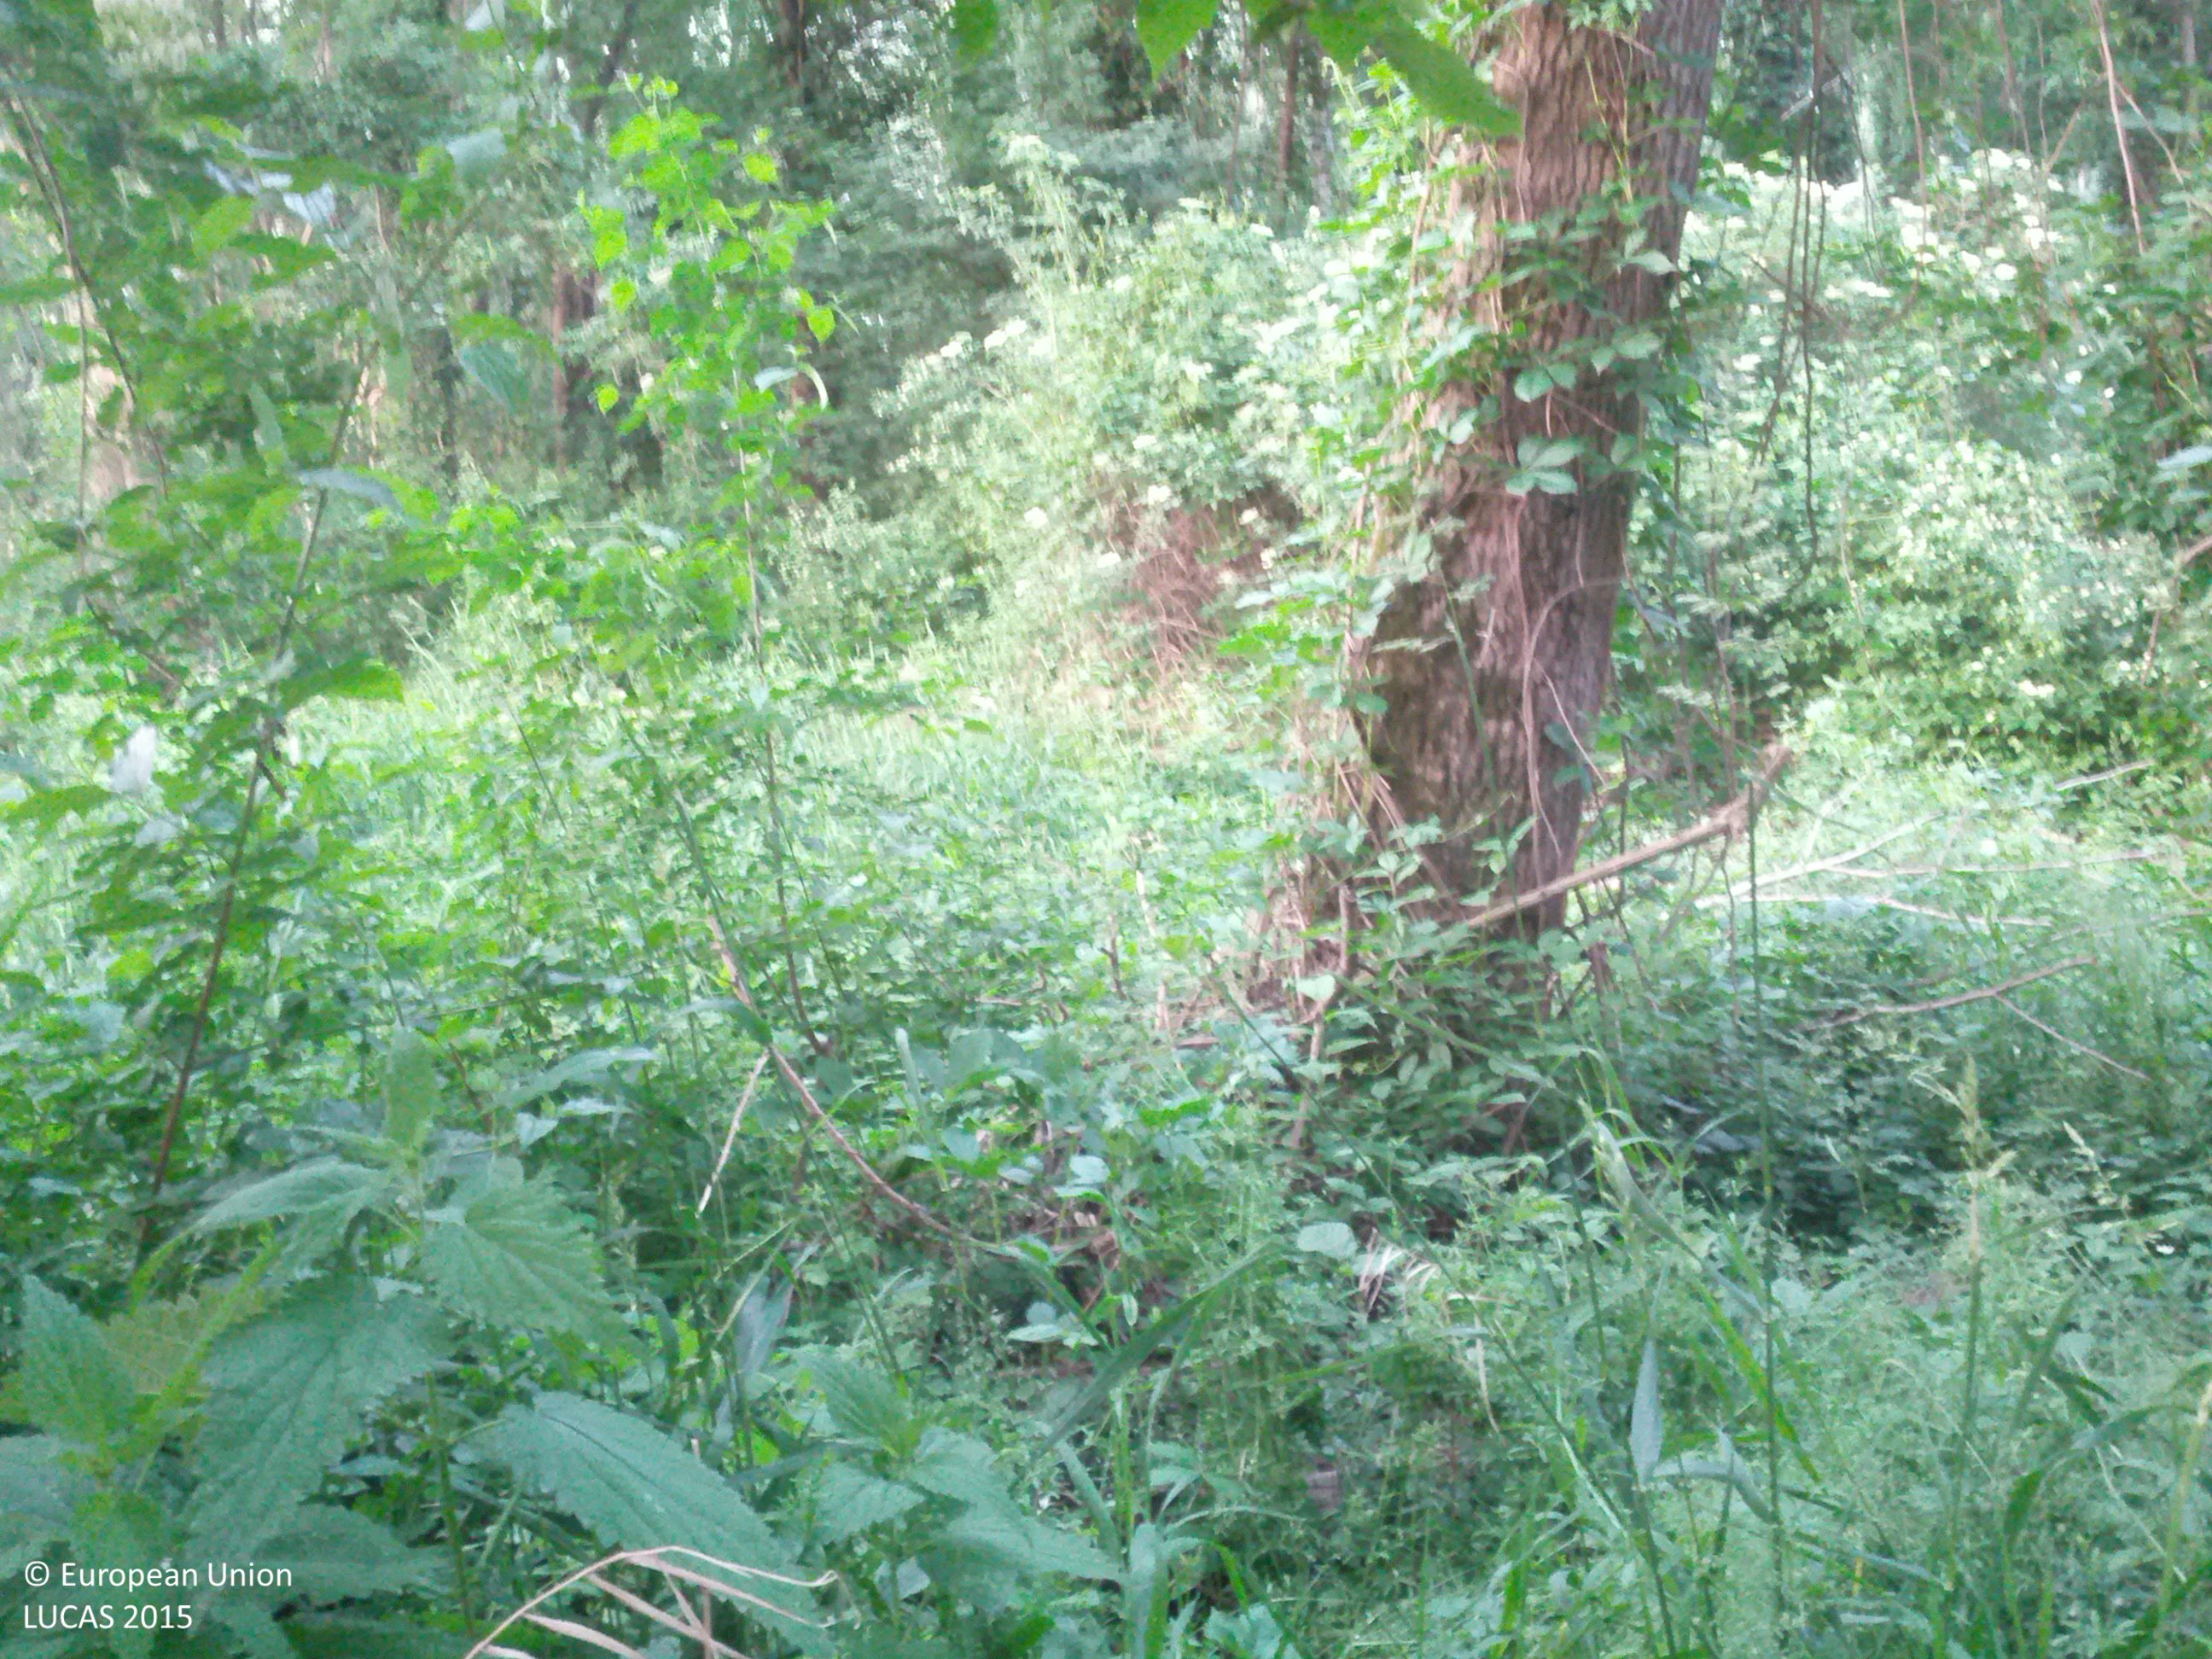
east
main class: Woodland
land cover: Broadleaved woodland
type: floodplain forest
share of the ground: 50 - 75 %
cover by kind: broadleaved forest trees 50 %, herbaceous plants 35 %, shrubs 15 %
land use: Forestry
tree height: > 5 m
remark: Temporary flooded
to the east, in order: Broadleaved woodland; Tracks; Broadleaved woodland
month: May
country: AT
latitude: 48.3319
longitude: 16.3044
